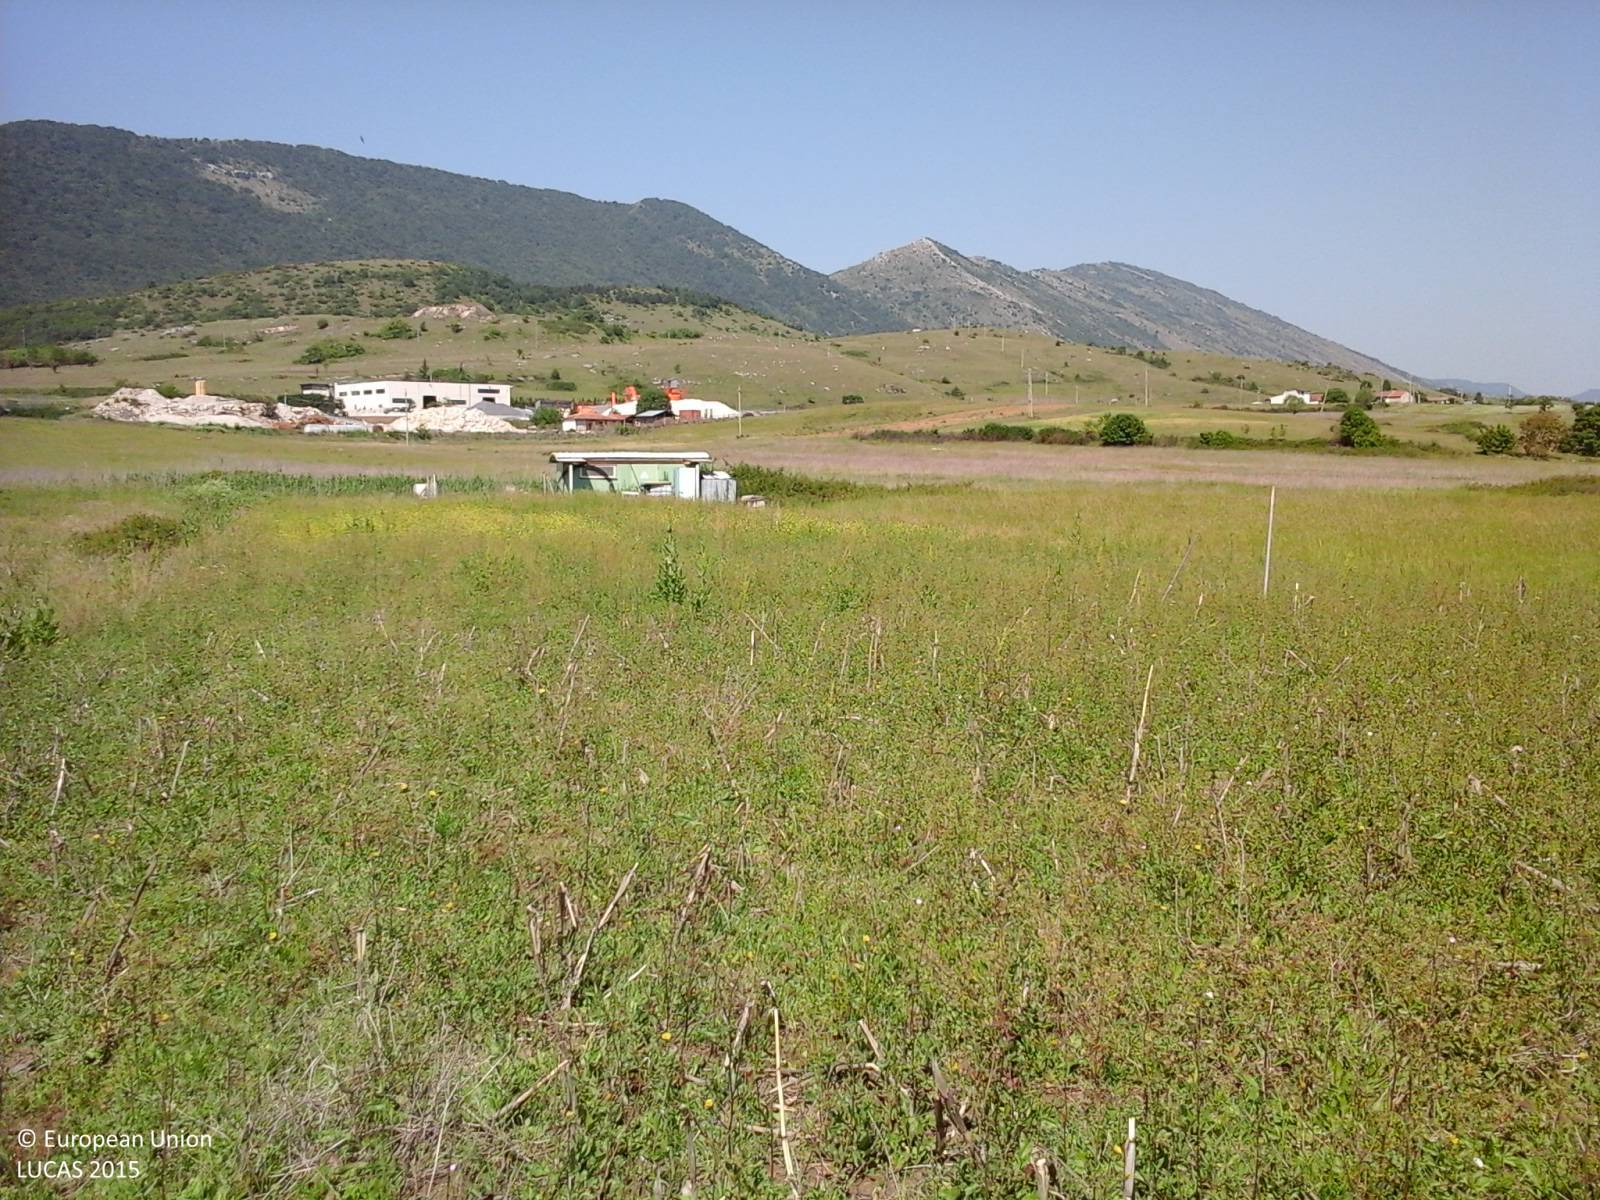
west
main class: Grassland
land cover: Spontaneously vegetated surfaces
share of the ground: > 75 %
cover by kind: herbaceous plants 100 %
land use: Fallow land
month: June
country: IT
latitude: 42.0010
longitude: 13.3807
